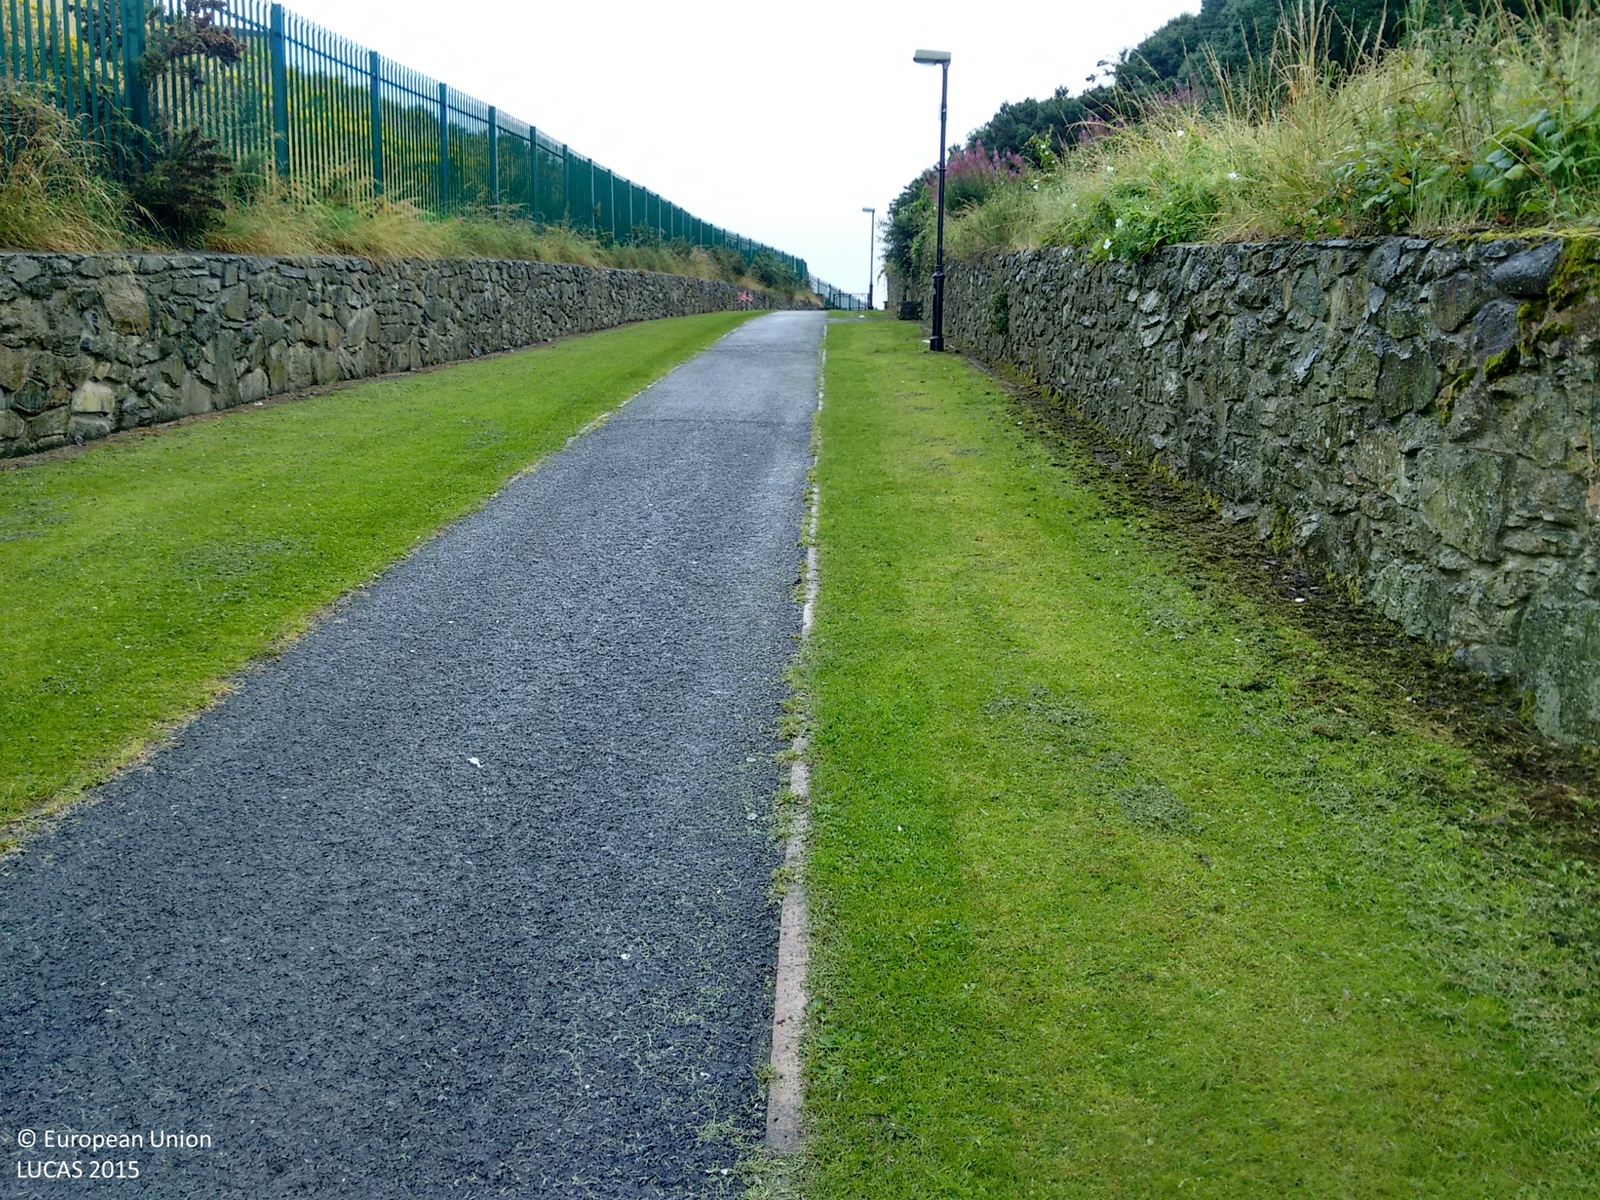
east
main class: Grassland
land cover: Grassland without tree/shrub cover
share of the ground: > 75 %
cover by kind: herbaceous plants 100 %
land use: Semi-natural and natural areas not in use
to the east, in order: Grassland without tree/shrub cover; Abandoned hedges; Grassland without tree/shrub cover; Artificial constructions in urban areas
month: August
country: GB
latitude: 54.3299
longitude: -5.7108
